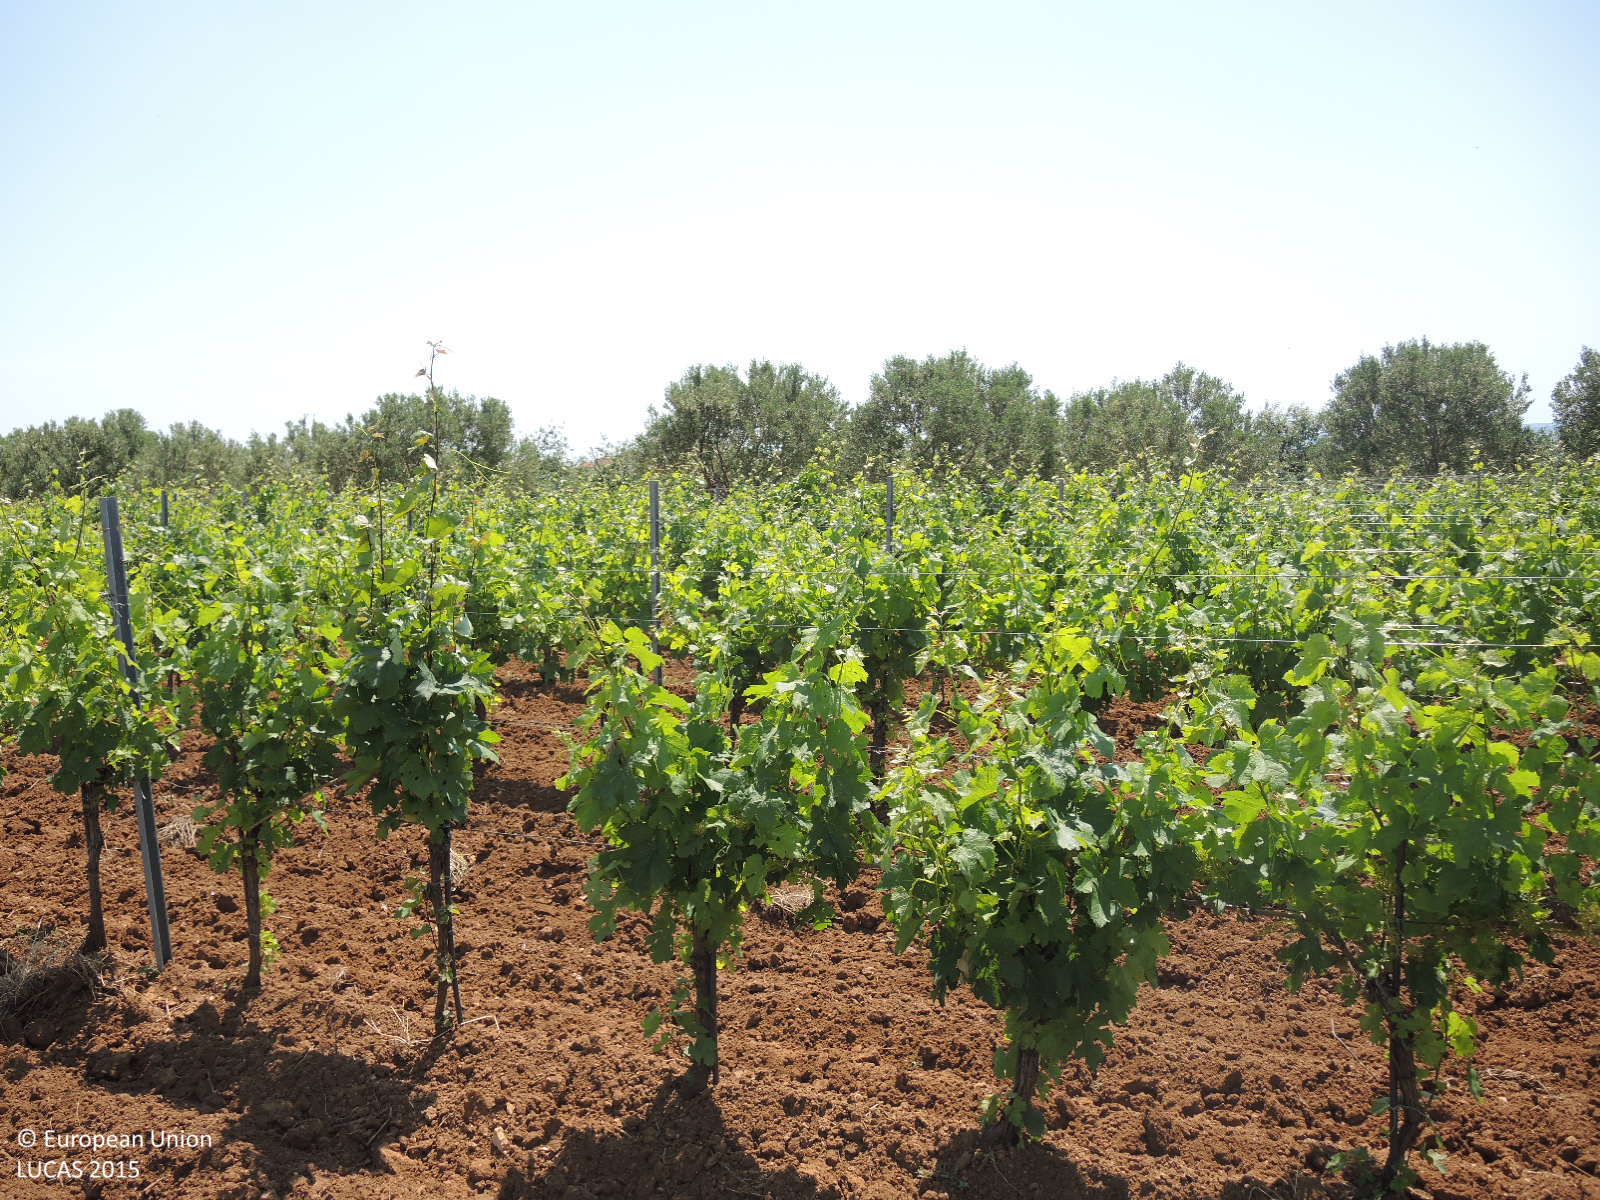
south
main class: Cropland
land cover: Other fresh vegetables
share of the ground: < 10 %
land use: Agriculture (excluding fallow land and kitchen gardens)
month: May
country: HR
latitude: 44.0782
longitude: 15.4989
